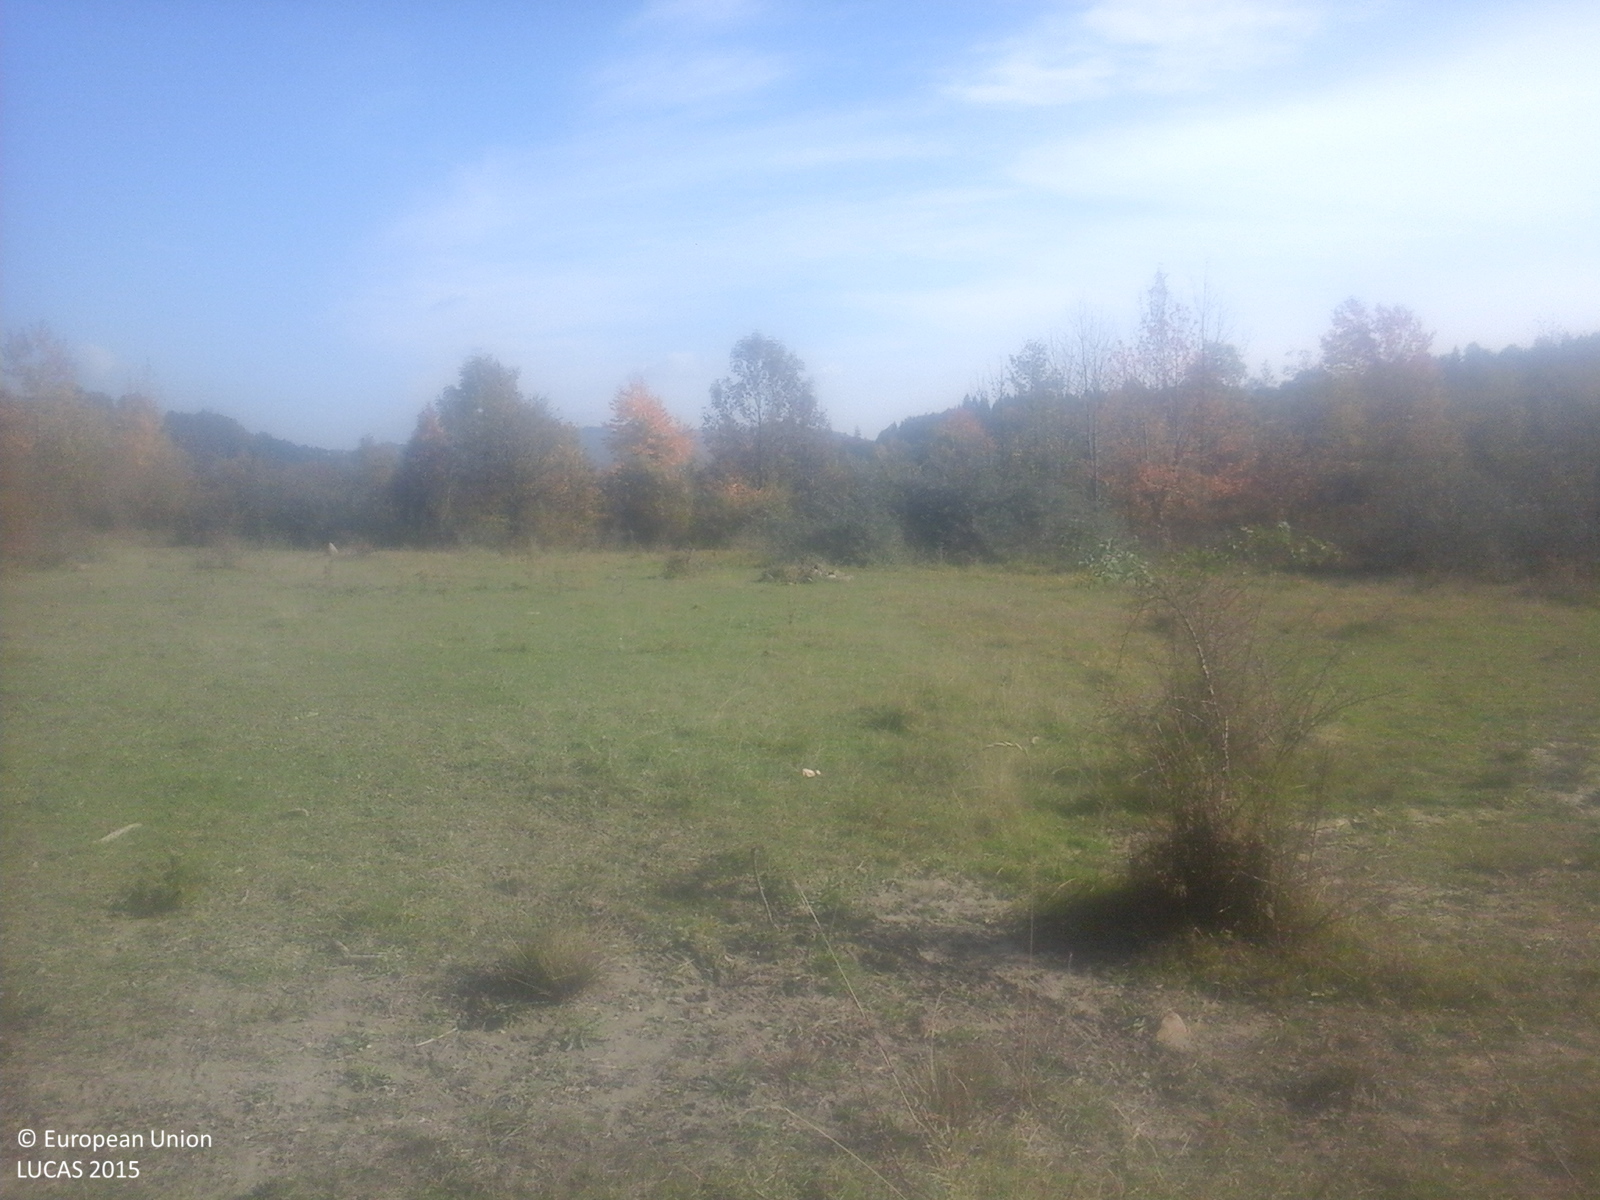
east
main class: Grassland
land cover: Grassland with sparse tree/shrub cover
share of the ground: > 75 %
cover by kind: herbaceous plants 85 %, shrubs 10 %, broadleaved forest trees 5 %
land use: Agriculture (excluding fallow land and kitchen gardens)
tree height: < 5 m
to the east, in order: Grassland with sparse tree/shrub cover; Shrubland with sparse tree cover; Tracks; Shrubland with sparse tree cover; Broadleaved woodland; Shrubland with sparse tree cover; Spontaneously vegetated surfaces; Tracks; Grassland with sparse tree/shrub cover; Inland fresh running water; Grassland with sparse tree/shrub cover; Shrubland with sparse tree cover
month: October
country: RO
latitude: 45.7080
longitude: 26.6897
